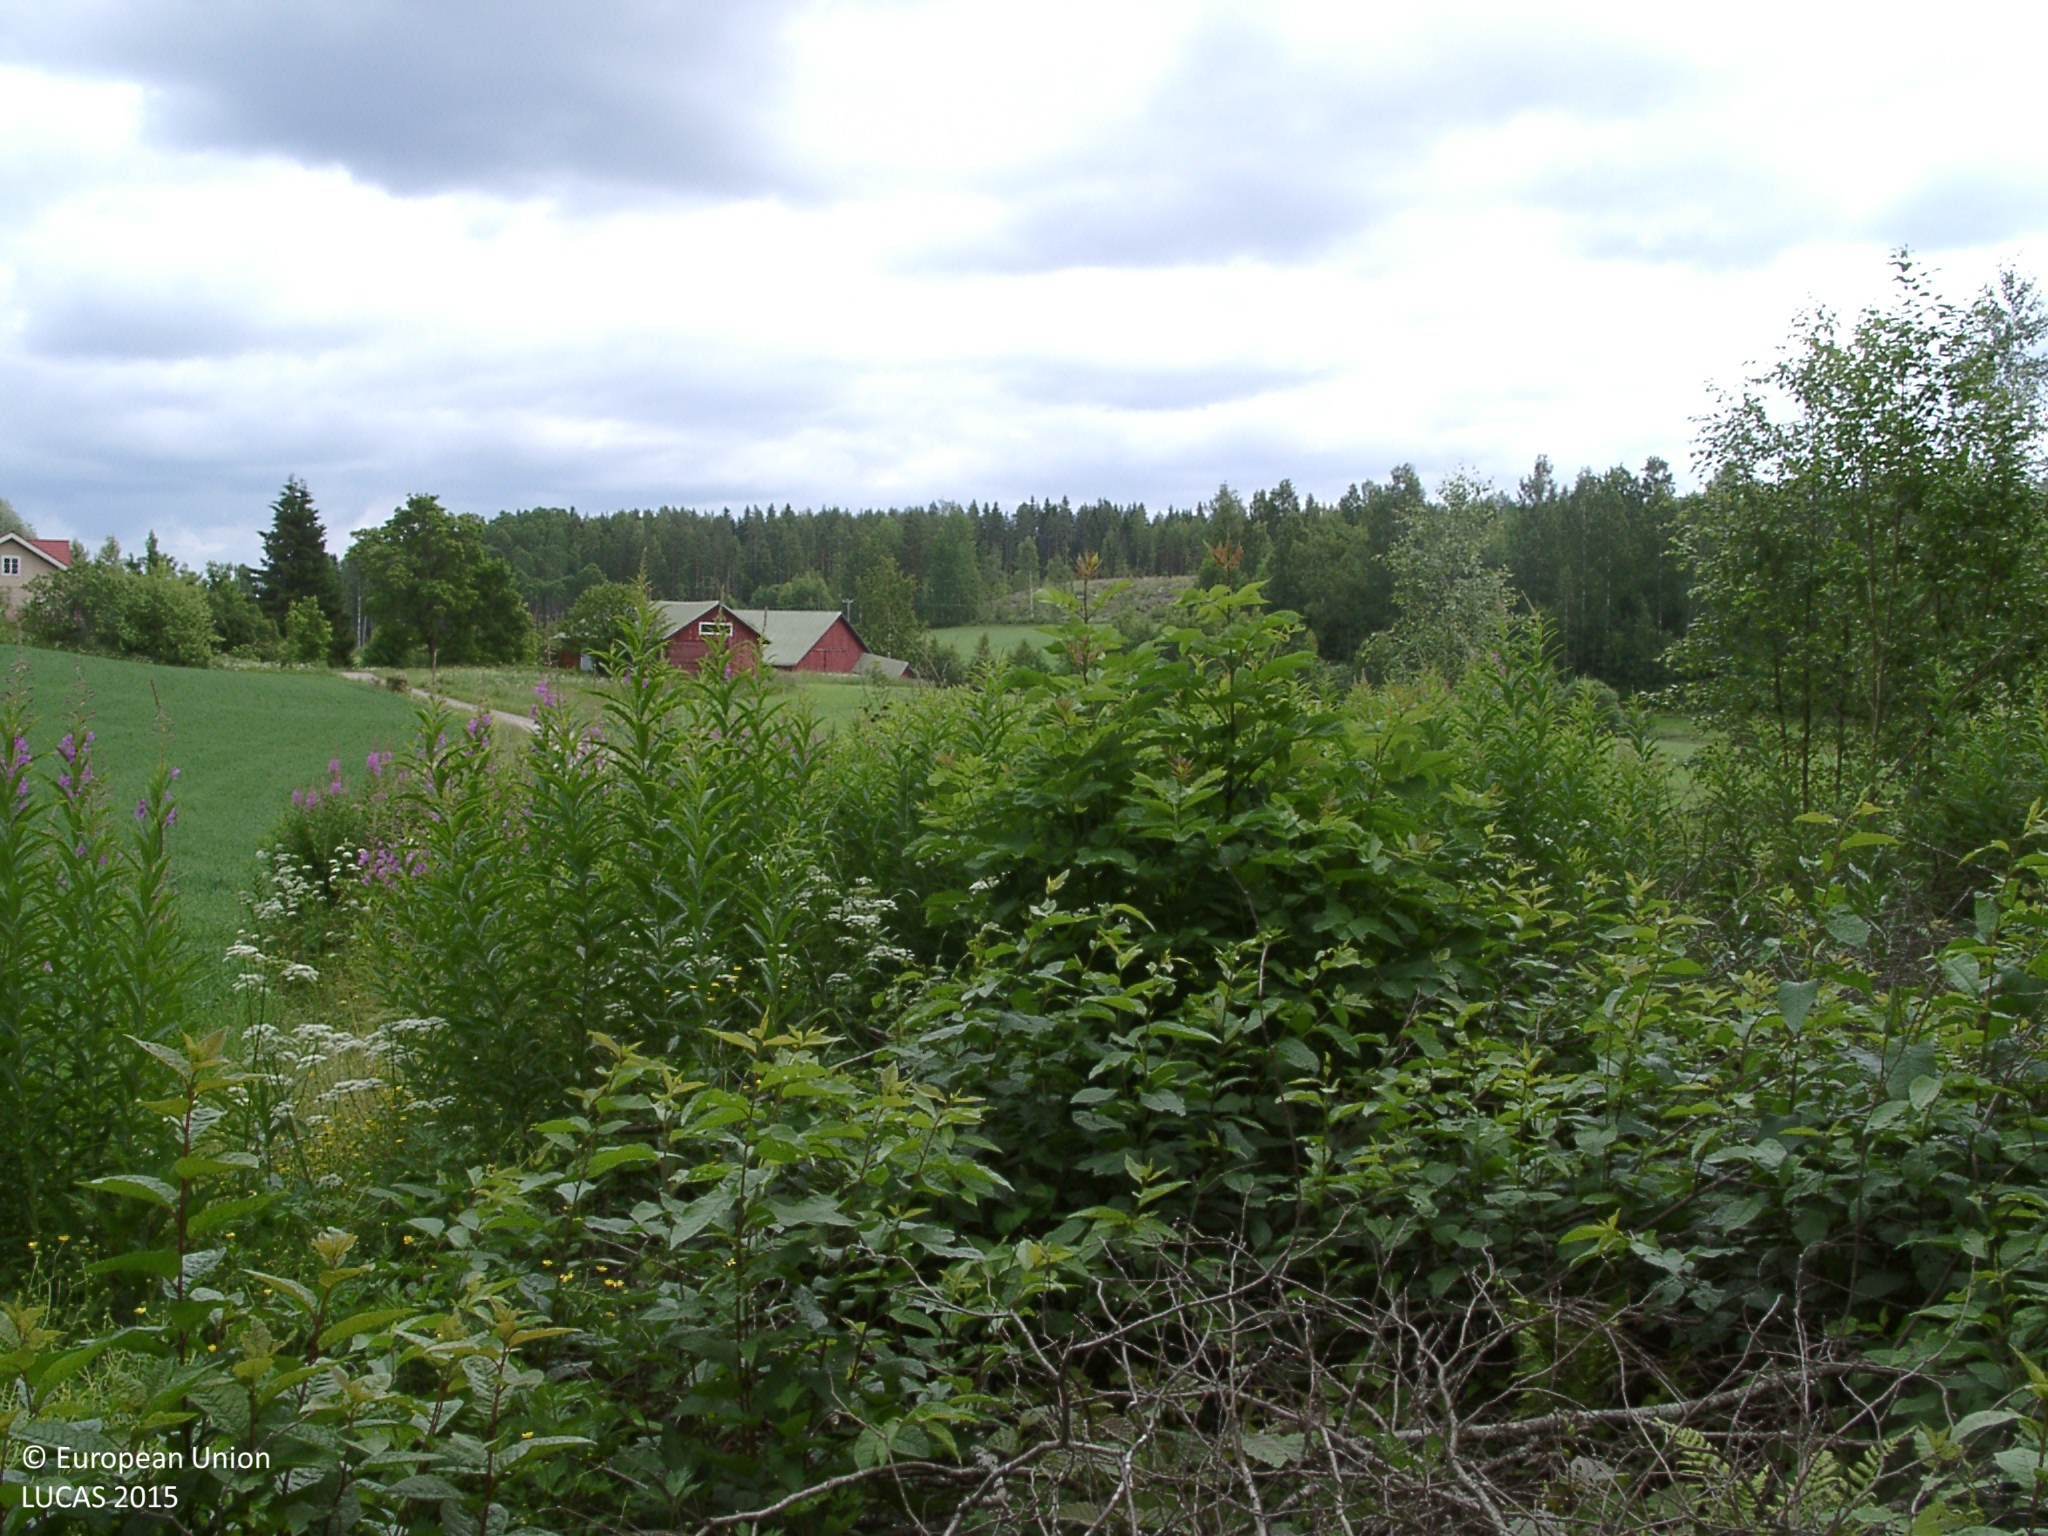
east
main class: Woodland
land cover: Broadleaved woodland
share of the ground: 25 - 50 %
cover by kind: broadleaved forest trees 45 %, herbaceous plants 10 %, shrubs 5 %, lichens and mosses 5 %
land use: Semi-natural and natural areas not in use
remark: Nursery
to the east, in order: Broadleaved woodland; Oats; Broadleaved woodland; Grassland without tree/shrub cover; Single bushes/trees; Electric lines; Oats; Broadleaved woodland
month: July
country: FI
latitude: 61.5236
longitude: 25.1727
